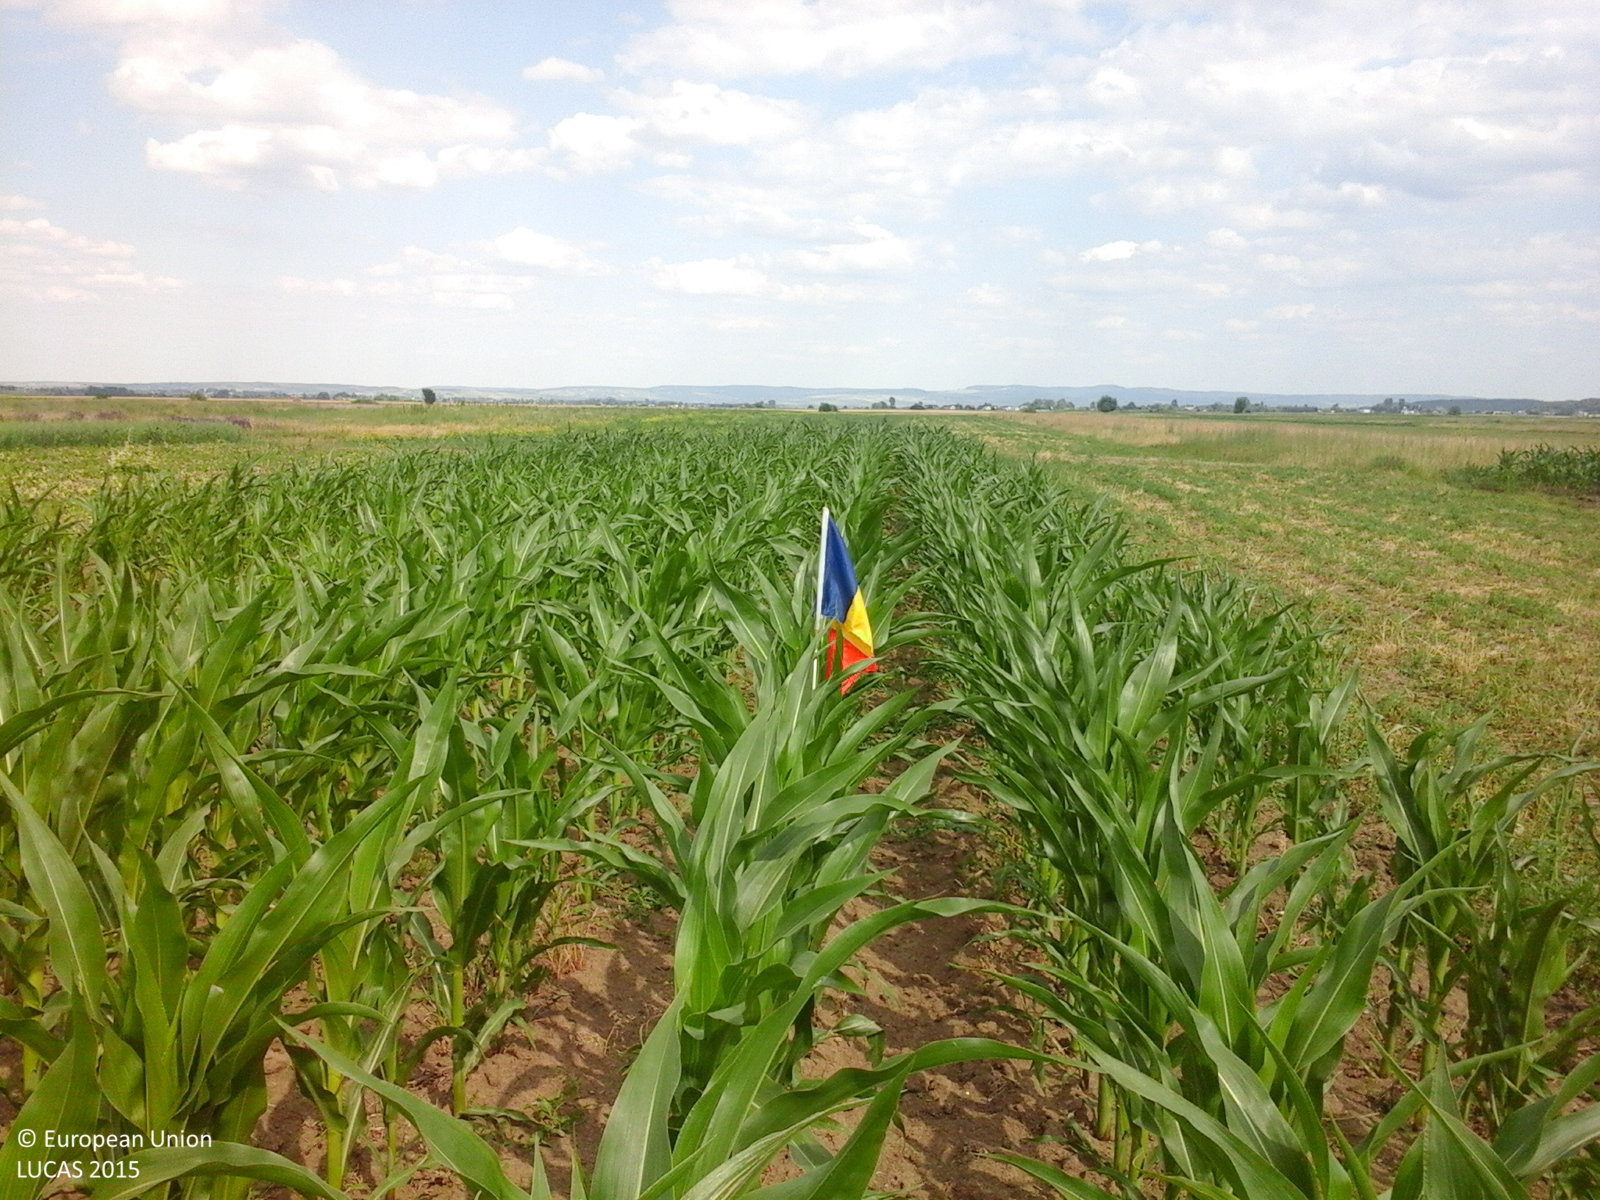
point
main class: Cropland
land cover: Maize
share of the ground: > 75 %
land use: Agriculture (excluding fallow land and kitchen gardens)
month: June
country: RO
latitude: 47.5856
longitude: 26.4292
